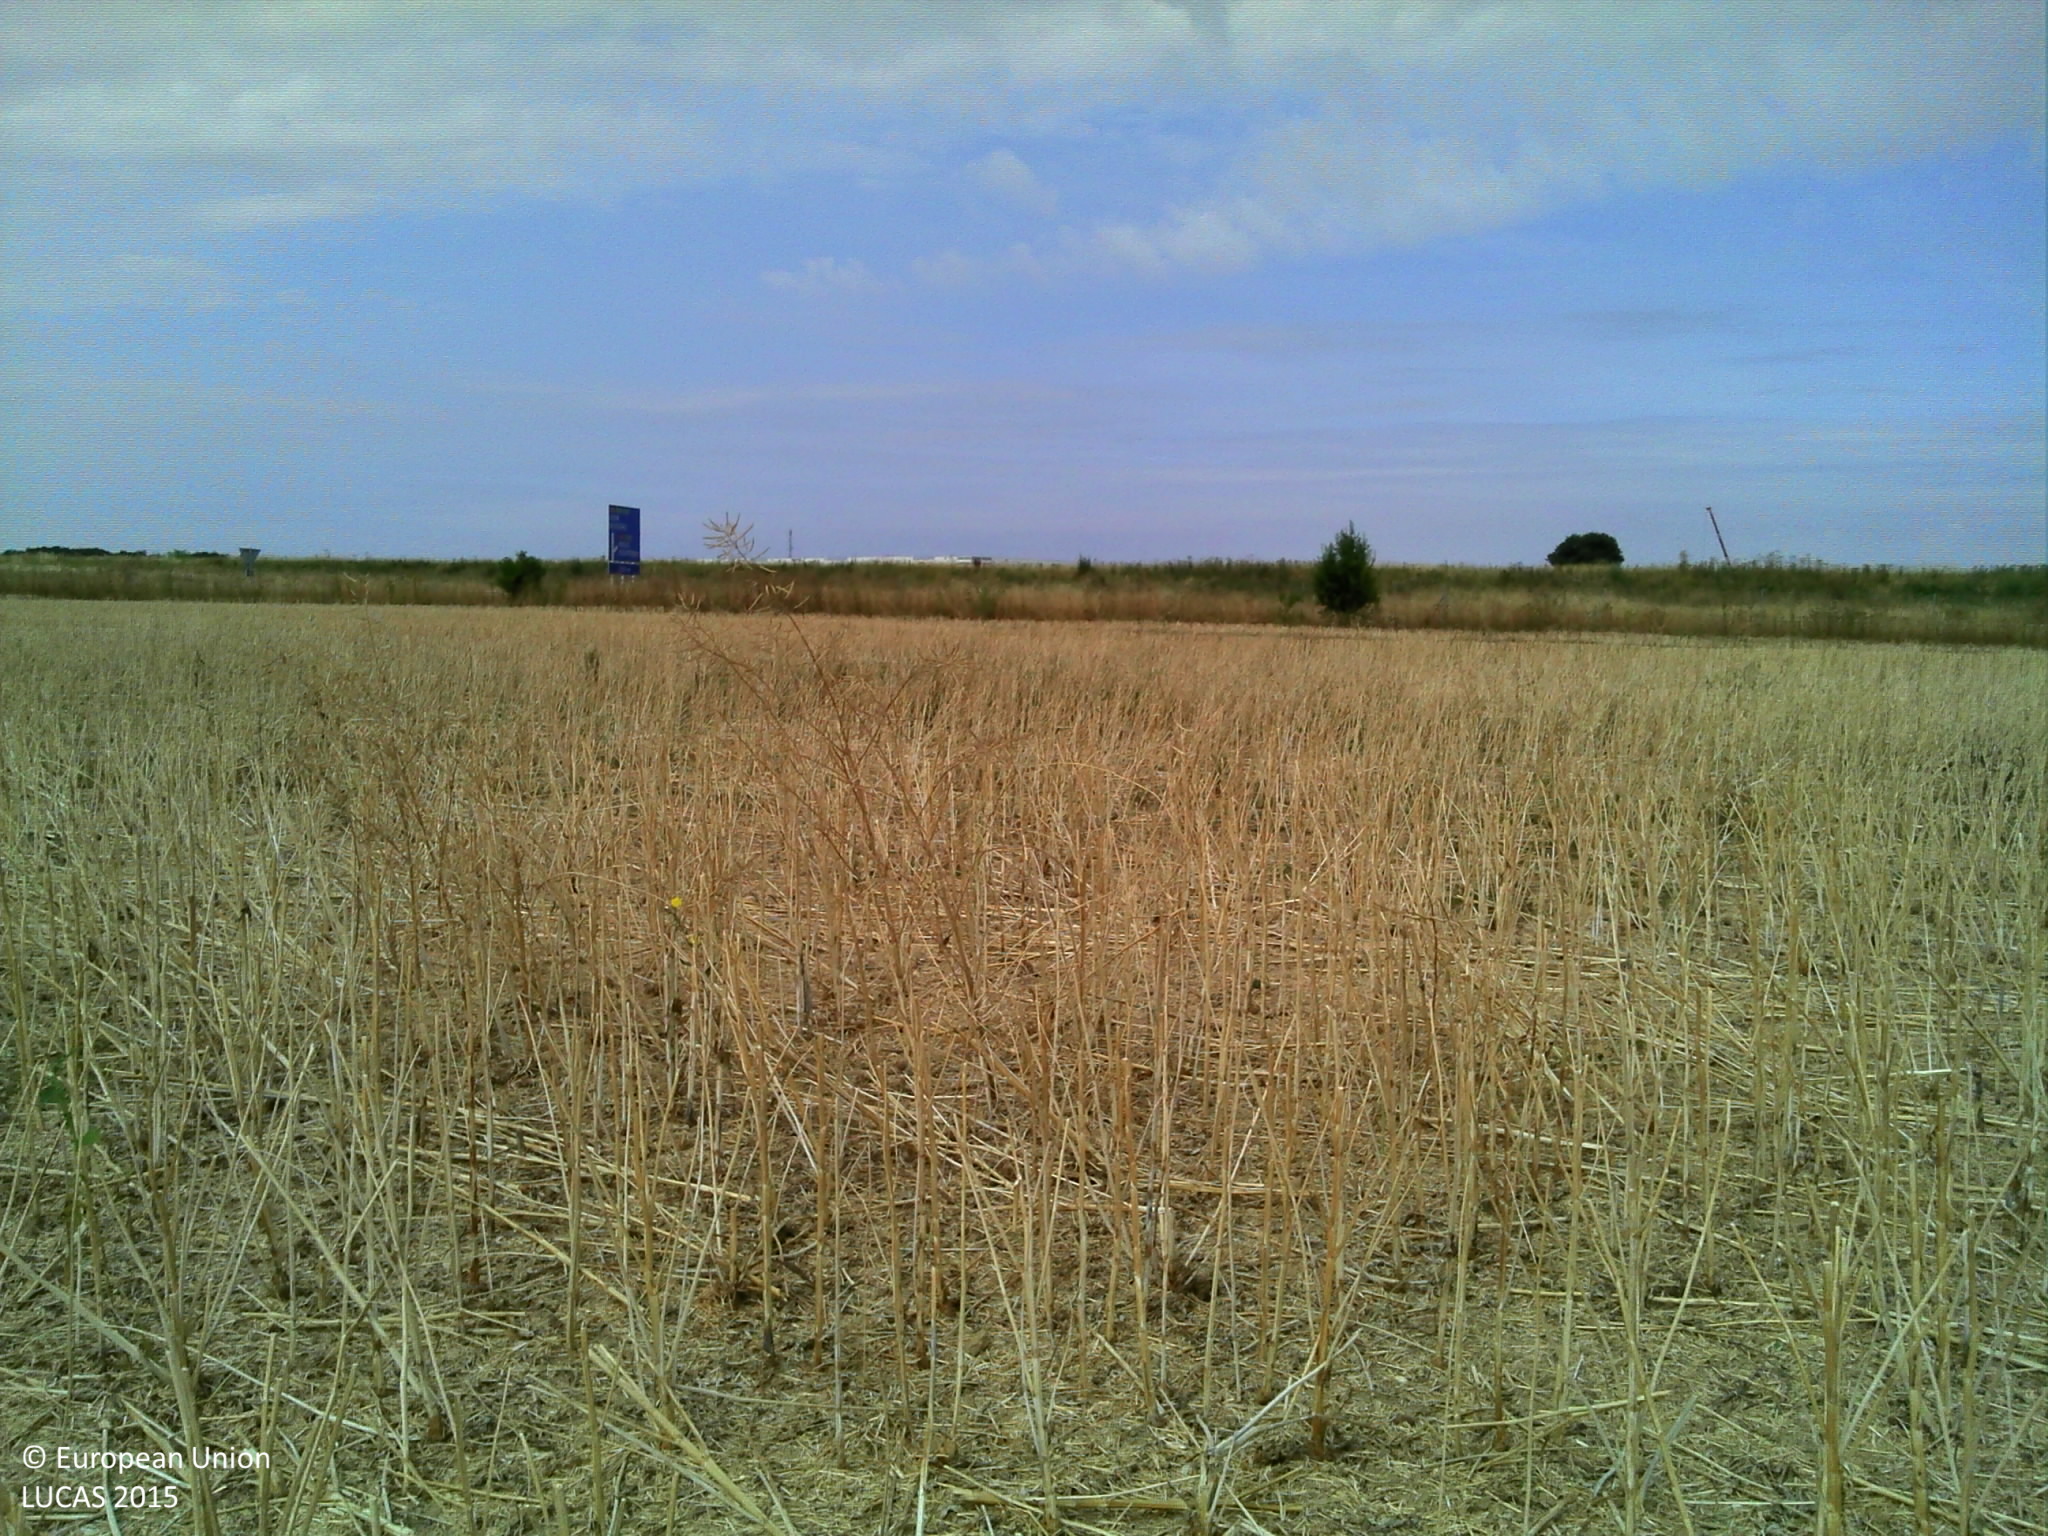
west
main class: Cropland
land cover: Rape and turnip rape
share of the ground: > 75 %
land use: Agriculture (excluding fallow land and kitchen gardens)
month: July
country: FR
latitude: 48.0620
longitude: 3.1095
